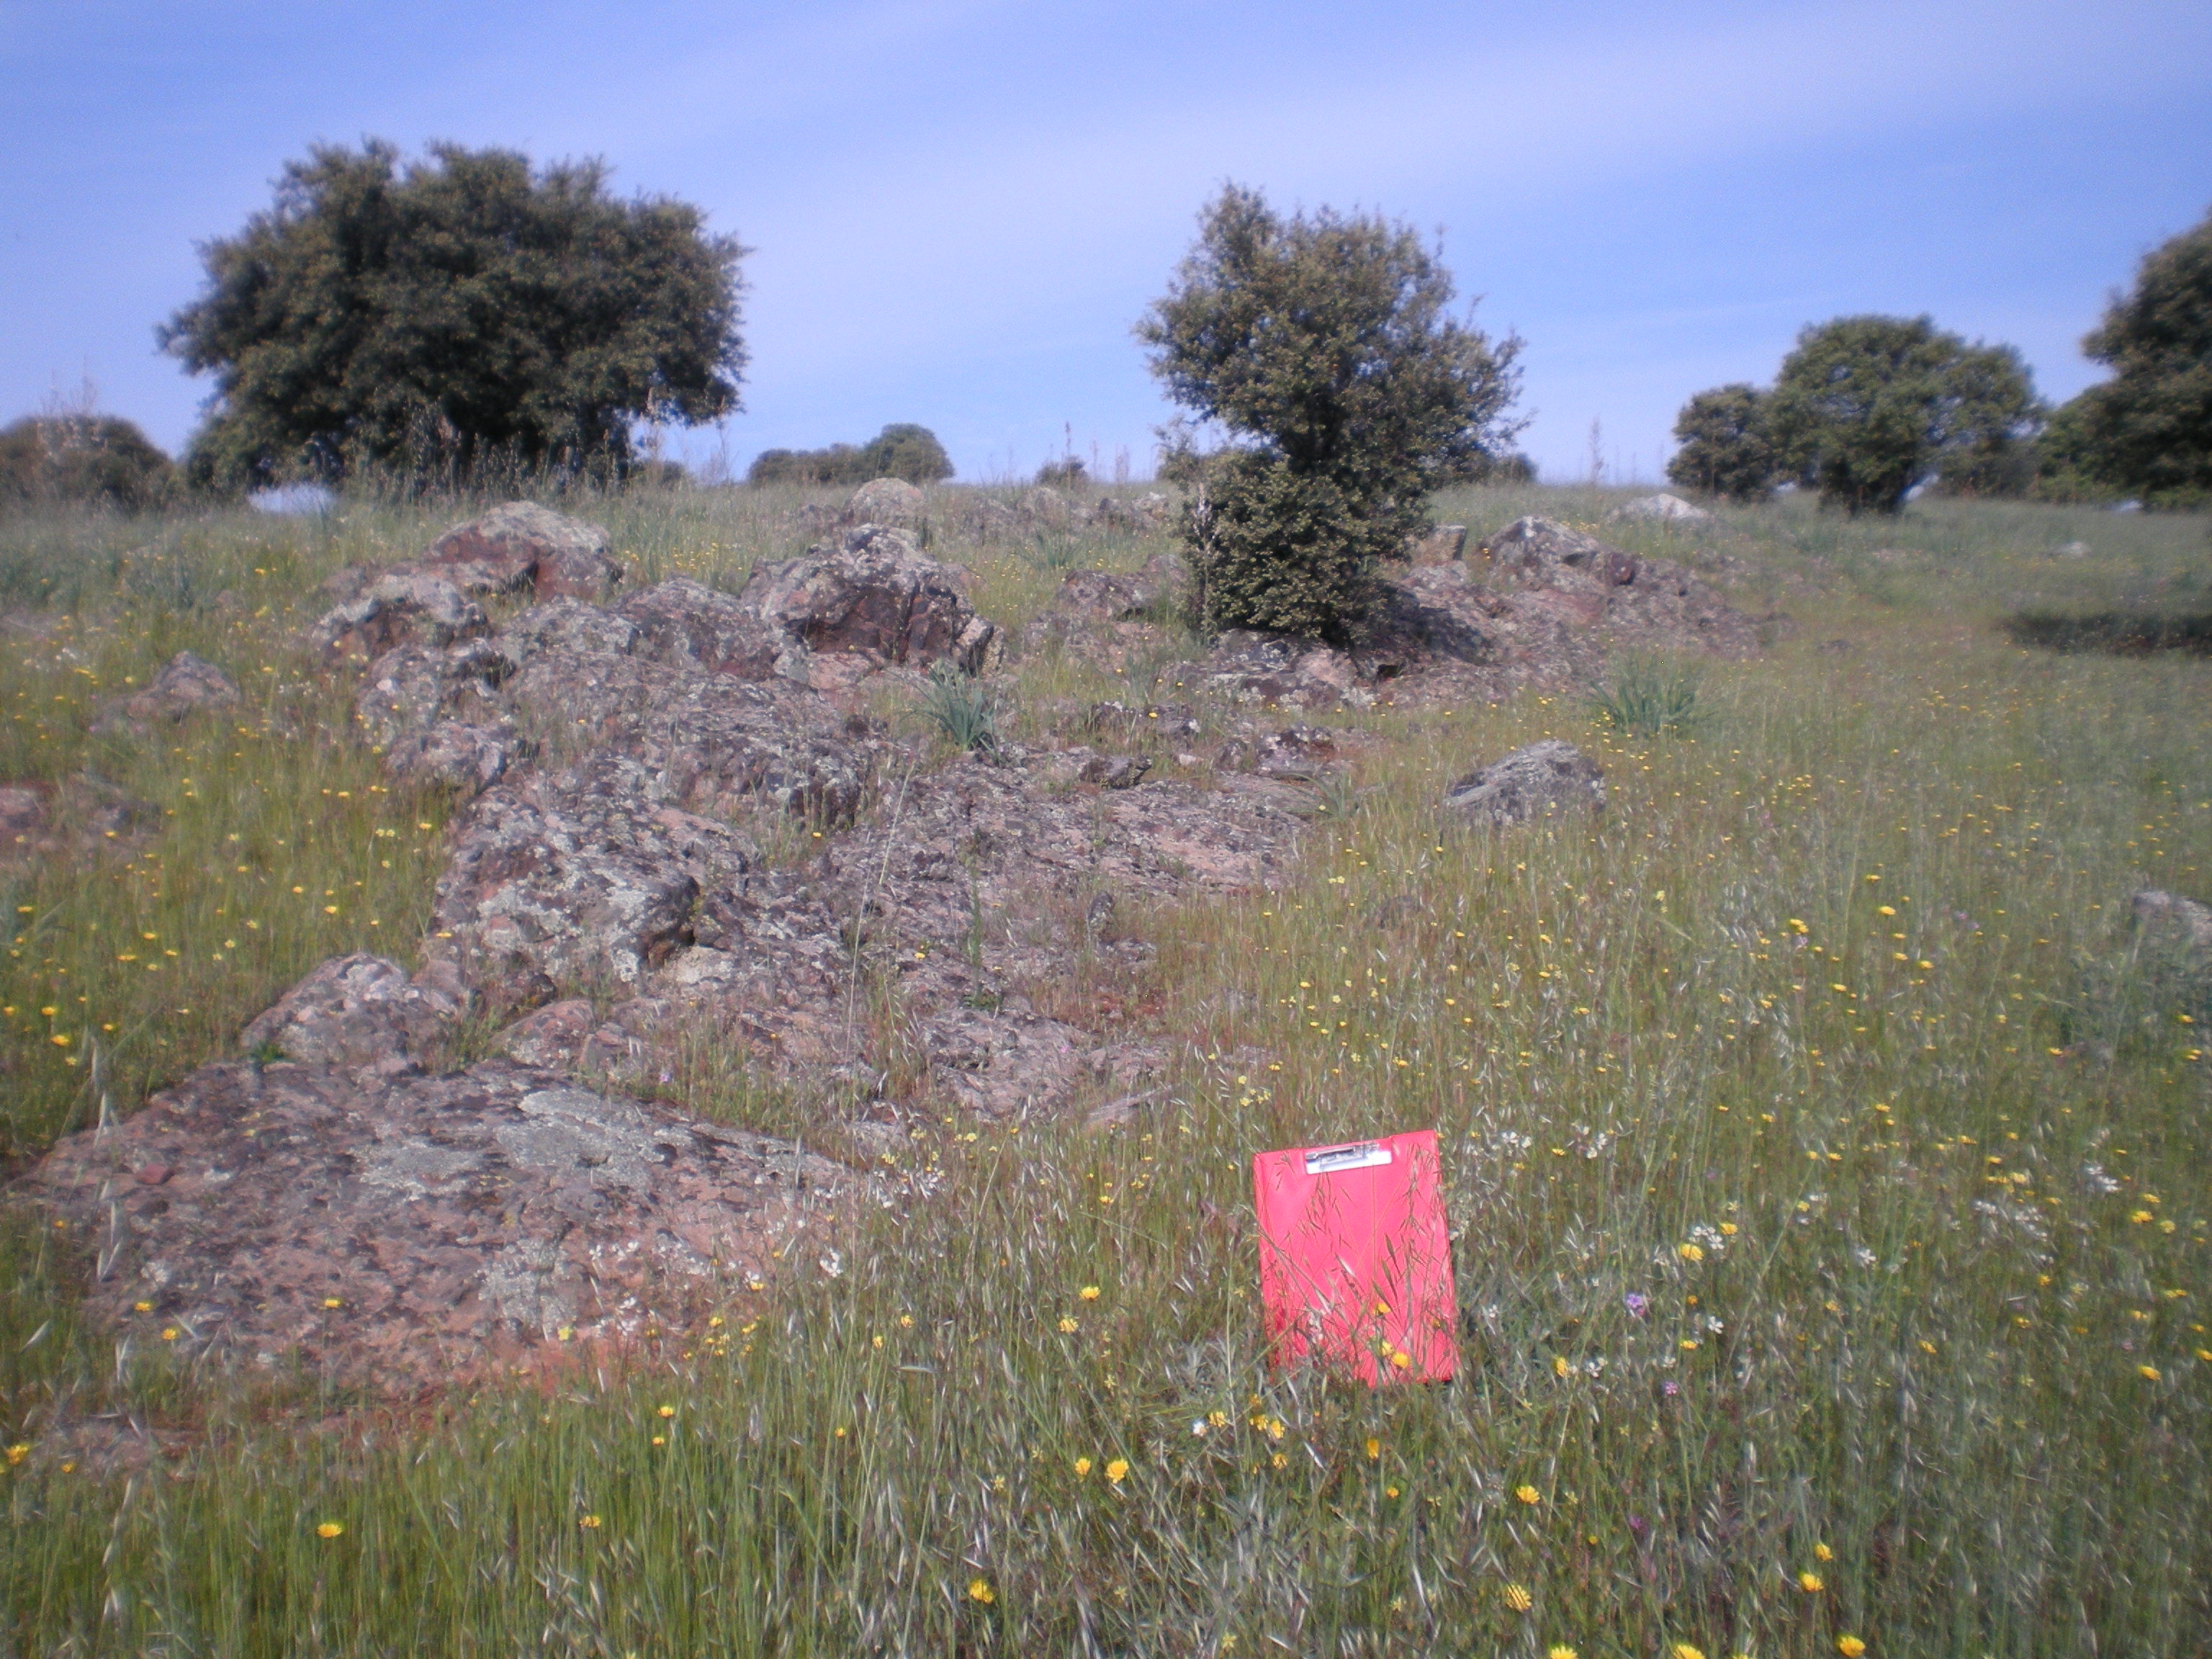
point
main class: Grassland
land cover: Grassland with sparse tree/shrub cover
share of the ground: > 75 %
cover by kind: herbaceous plants 80 %, consolidated bare surface 15 %, broadleaved forest trees 5 %
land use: Agriculture (excluding fallow land and kitchen gardens)
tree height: < 5 m
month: April
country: ES
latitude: 38.7243
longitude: -3.5038
